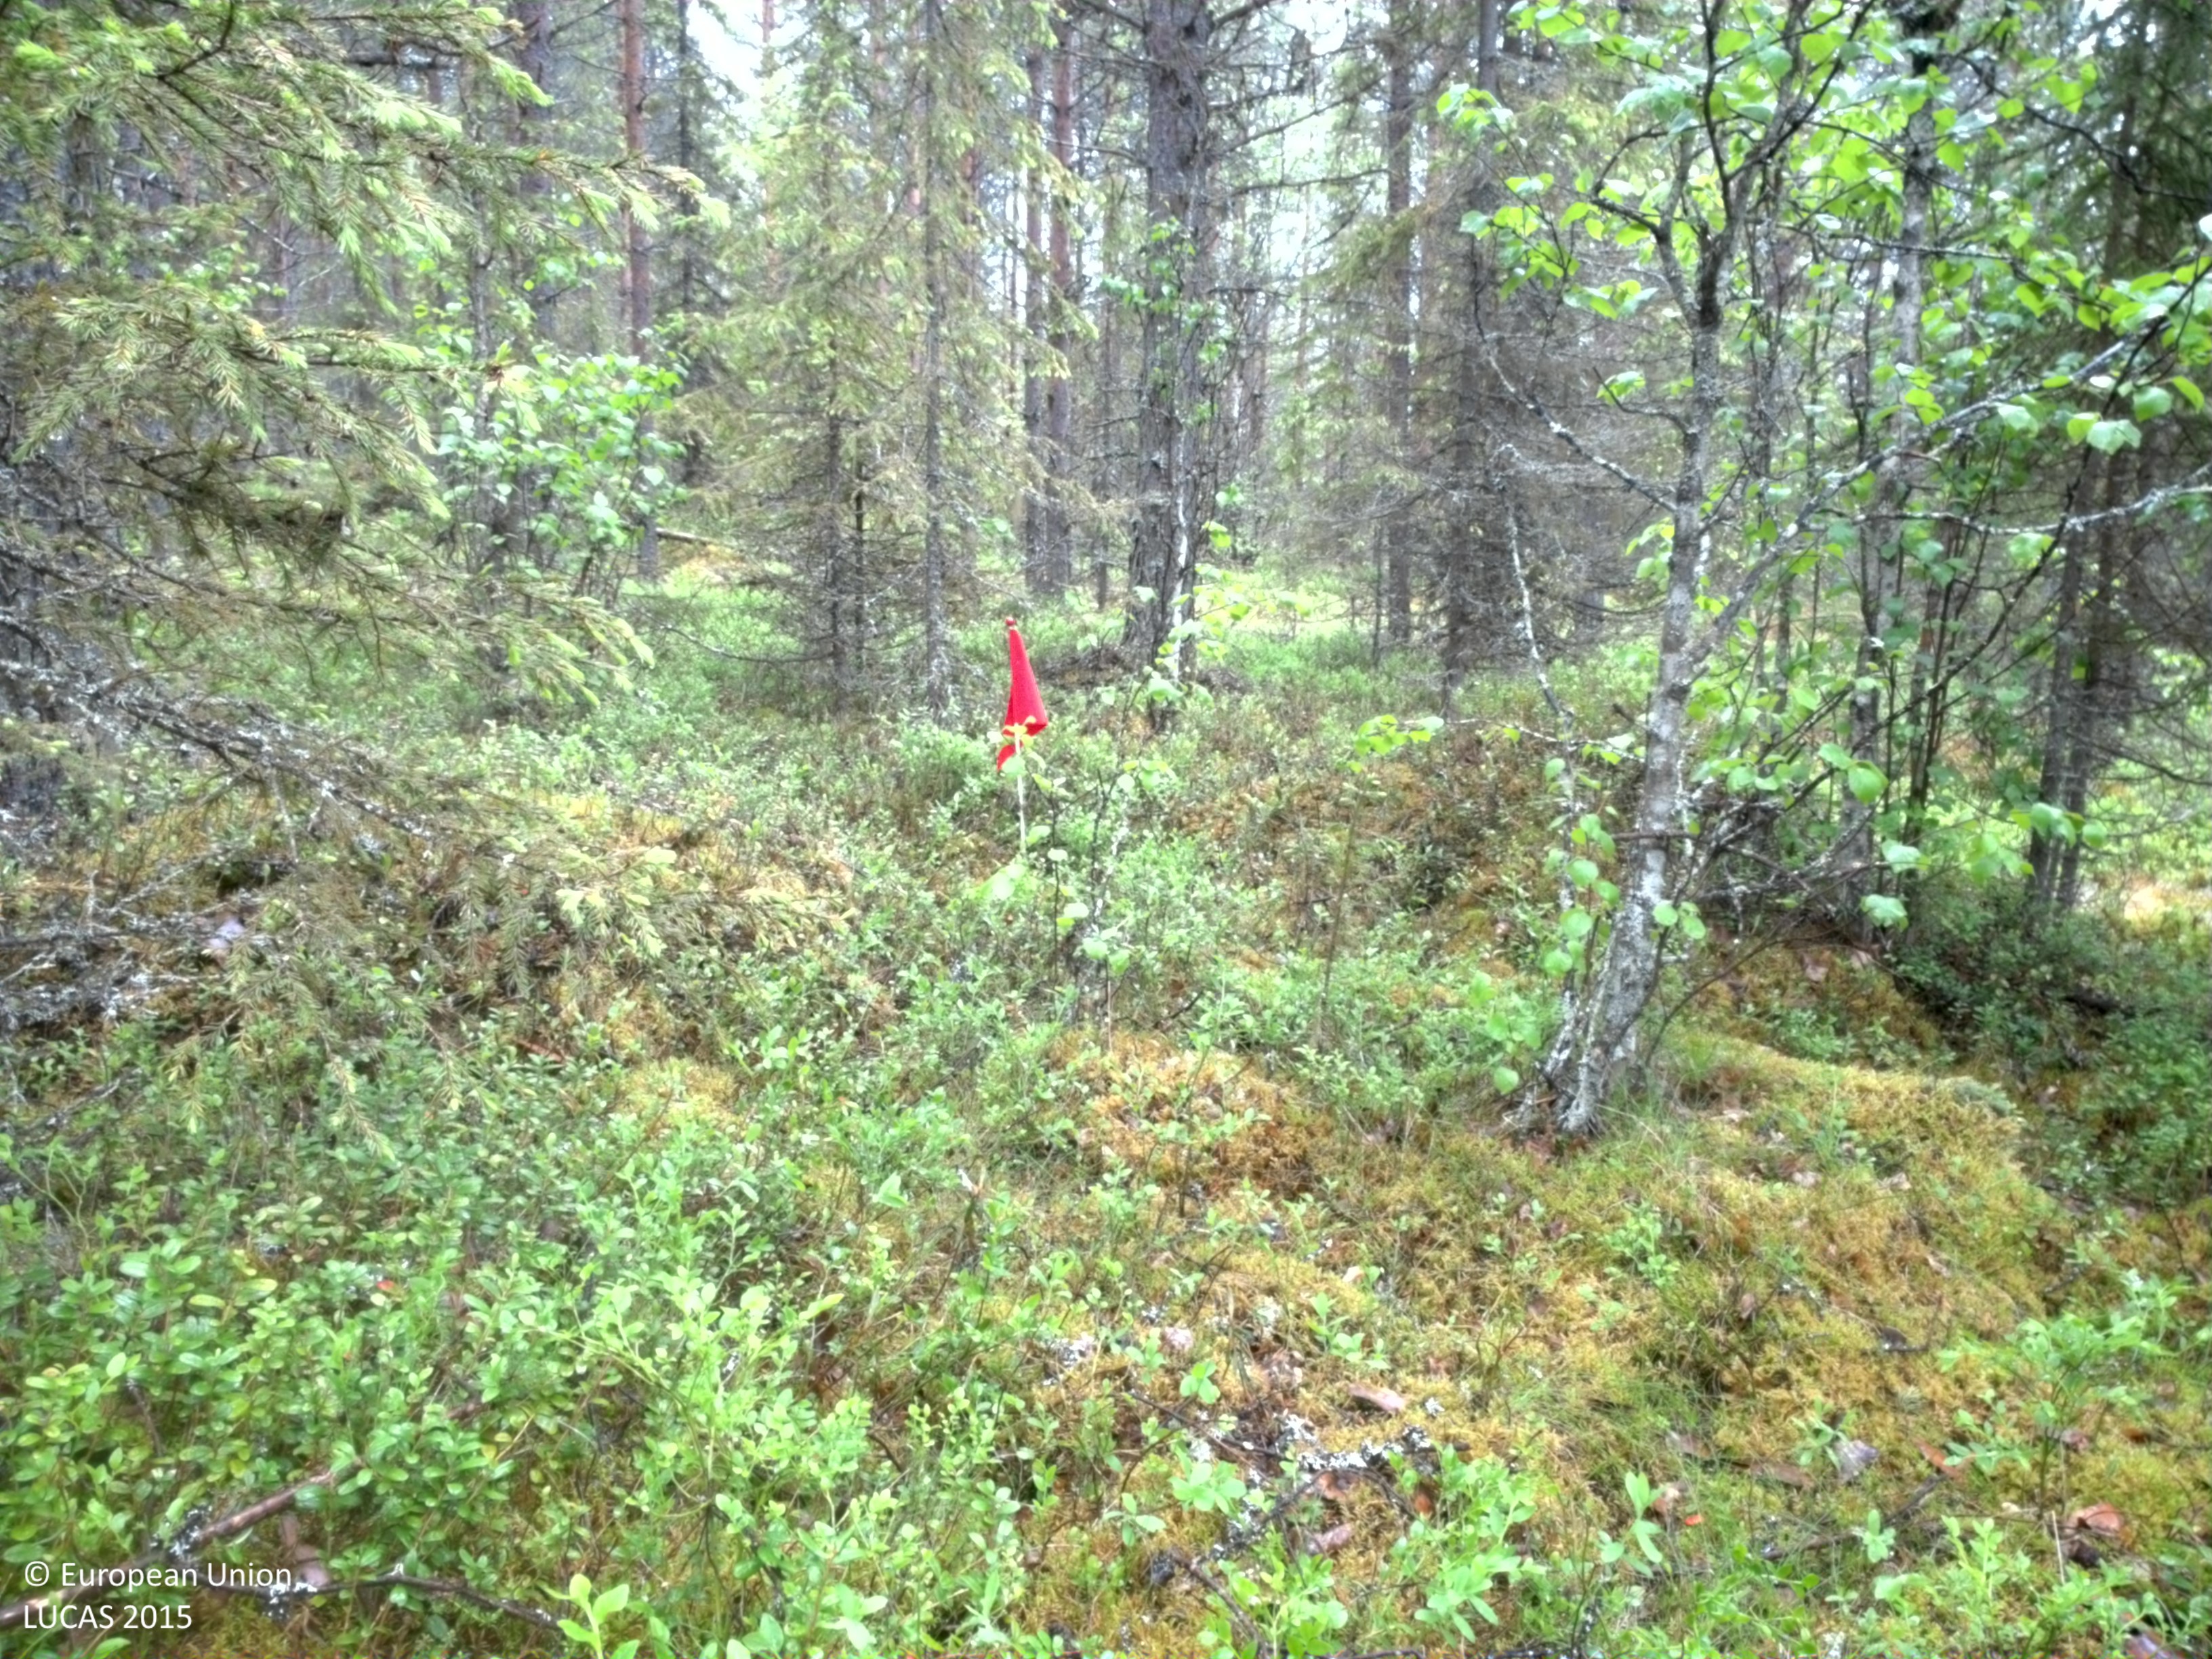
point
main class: Woodland
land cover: Pine dominated coniferous woodland
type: boreal forest
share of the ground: 25 - 50 %
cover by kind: shrubs 50 %, coniferous forest trees 40 %, broadleaved forest trees 5 %, lichens and mosses 5 %
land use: Forestry
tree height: > 5 m
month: June
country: SE
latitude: 66.5355
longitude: 22.8714
